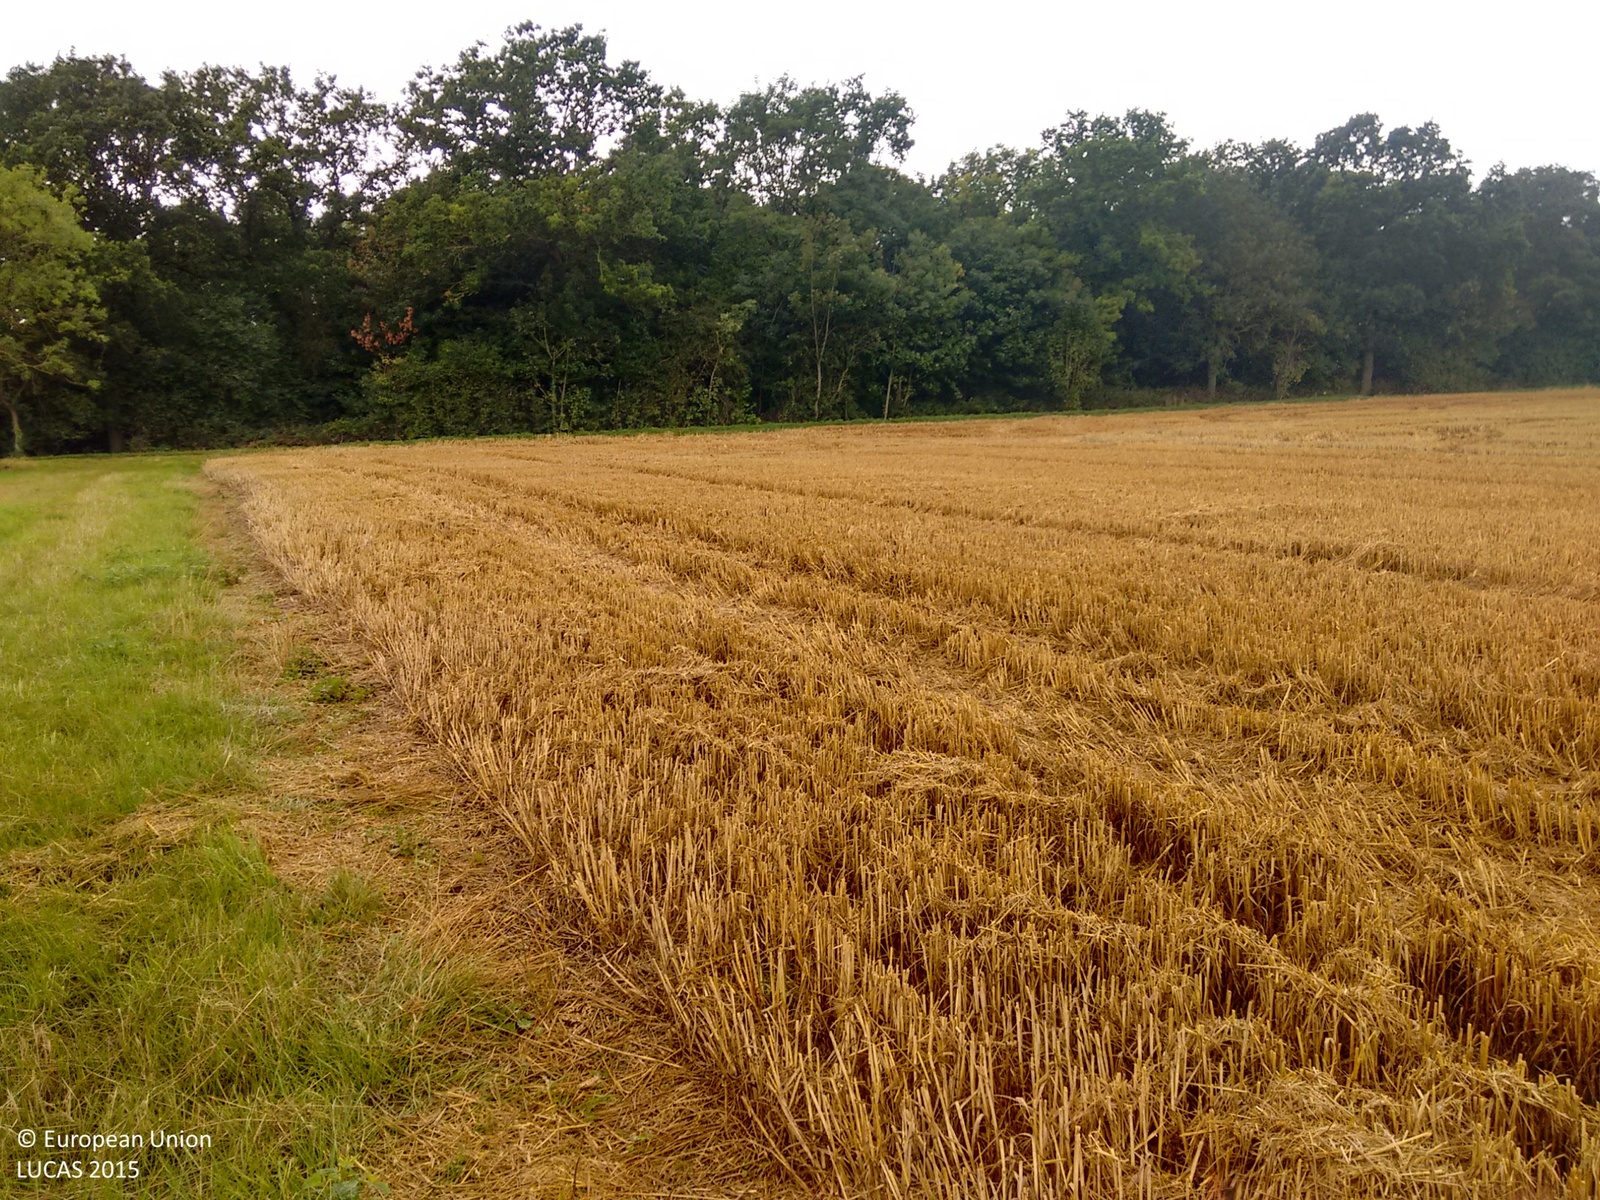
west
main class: Cropland
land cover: Common wheat
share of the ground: > 75 %
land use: Agriculture (excluding fallow land and kitchen gardens)
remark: Harvested field
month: August
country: GB
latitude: 52.1196
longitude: 0.4642
